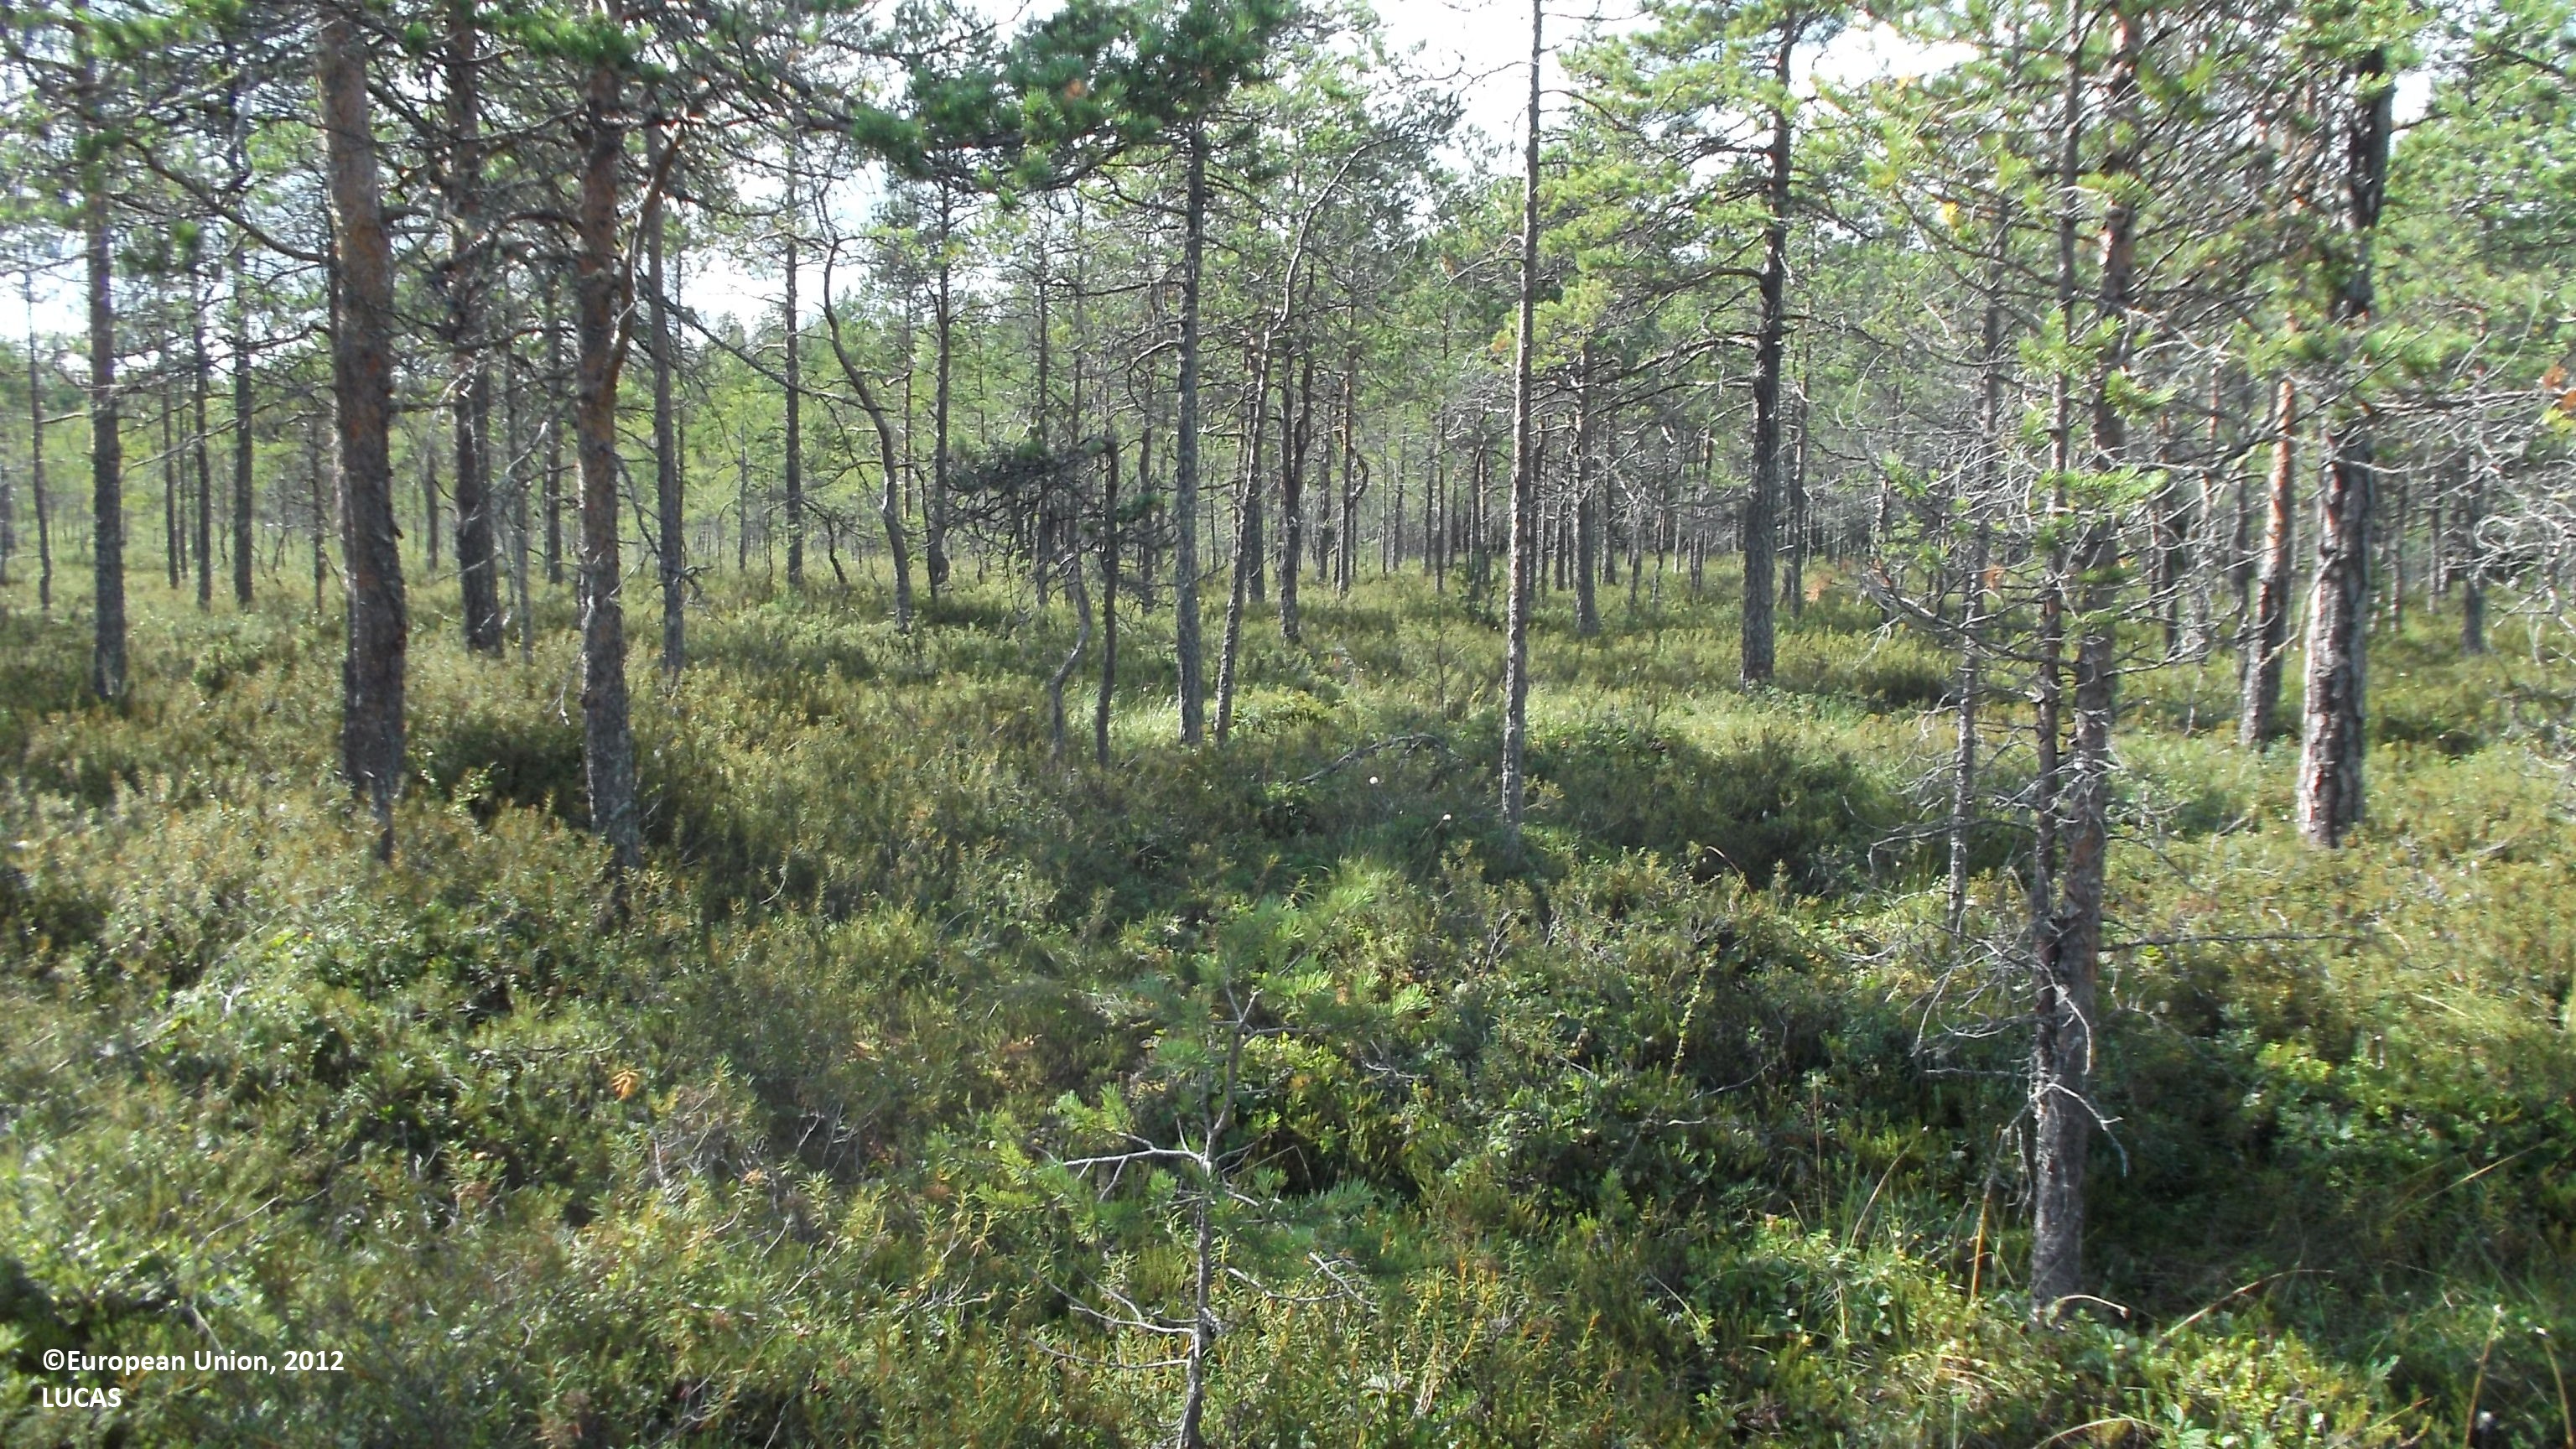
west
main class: Woodland
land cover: Pine dominated coniferous woodland
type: mire and swamp forests
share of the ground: 10 - 25 %
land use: Semi-natural and natural areas not in use
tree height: > 5 m
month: August
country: FI
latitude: 63.9427
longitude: 23.5454
